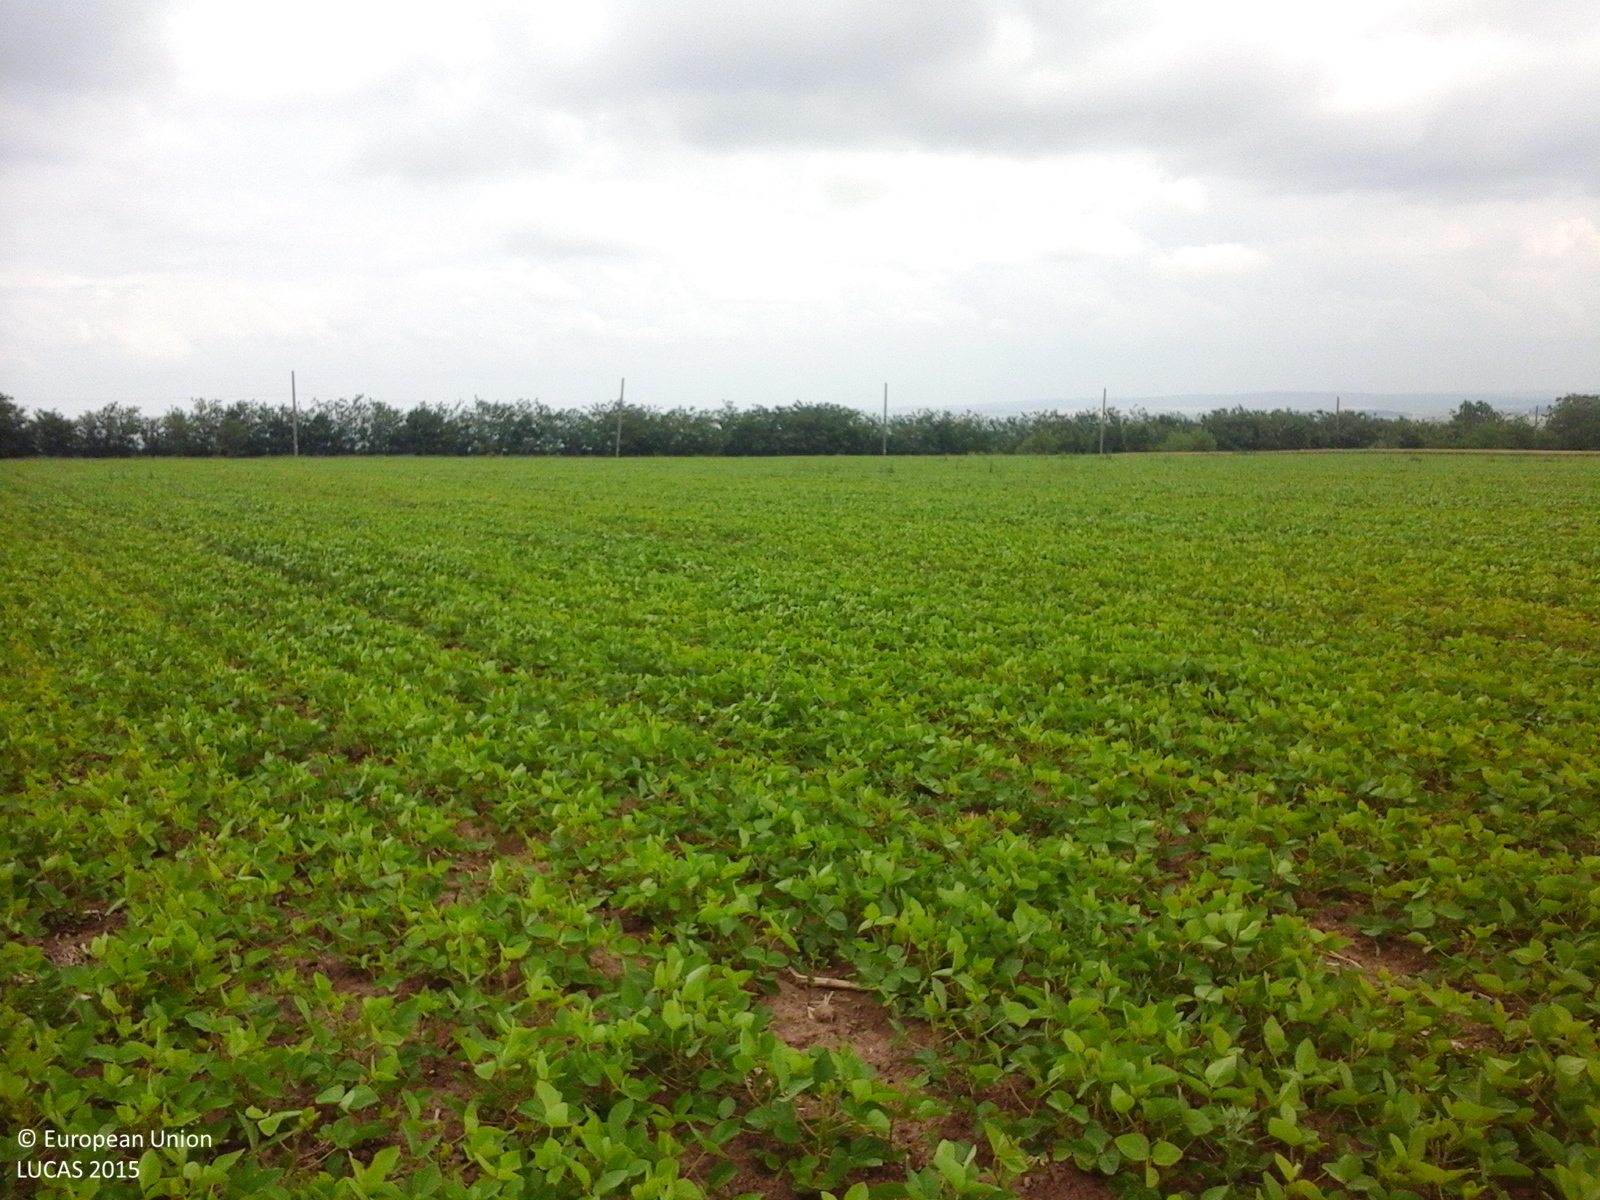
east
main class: Cropland
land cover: Soya
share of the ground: > 75 %
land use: Agriculture (excluding fallow land and kitchen gardens)
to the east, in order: Soya; Grass margins; Tracks; Grass margins; Ditches and canals; Electric lines; Lines of trees; Other leguminous and mixtures for fodder; Rape and turnip rape; Maize; Other leguminous and mixtures for fodder
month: June
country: RO
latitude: 47.2363
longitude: 26.6696
